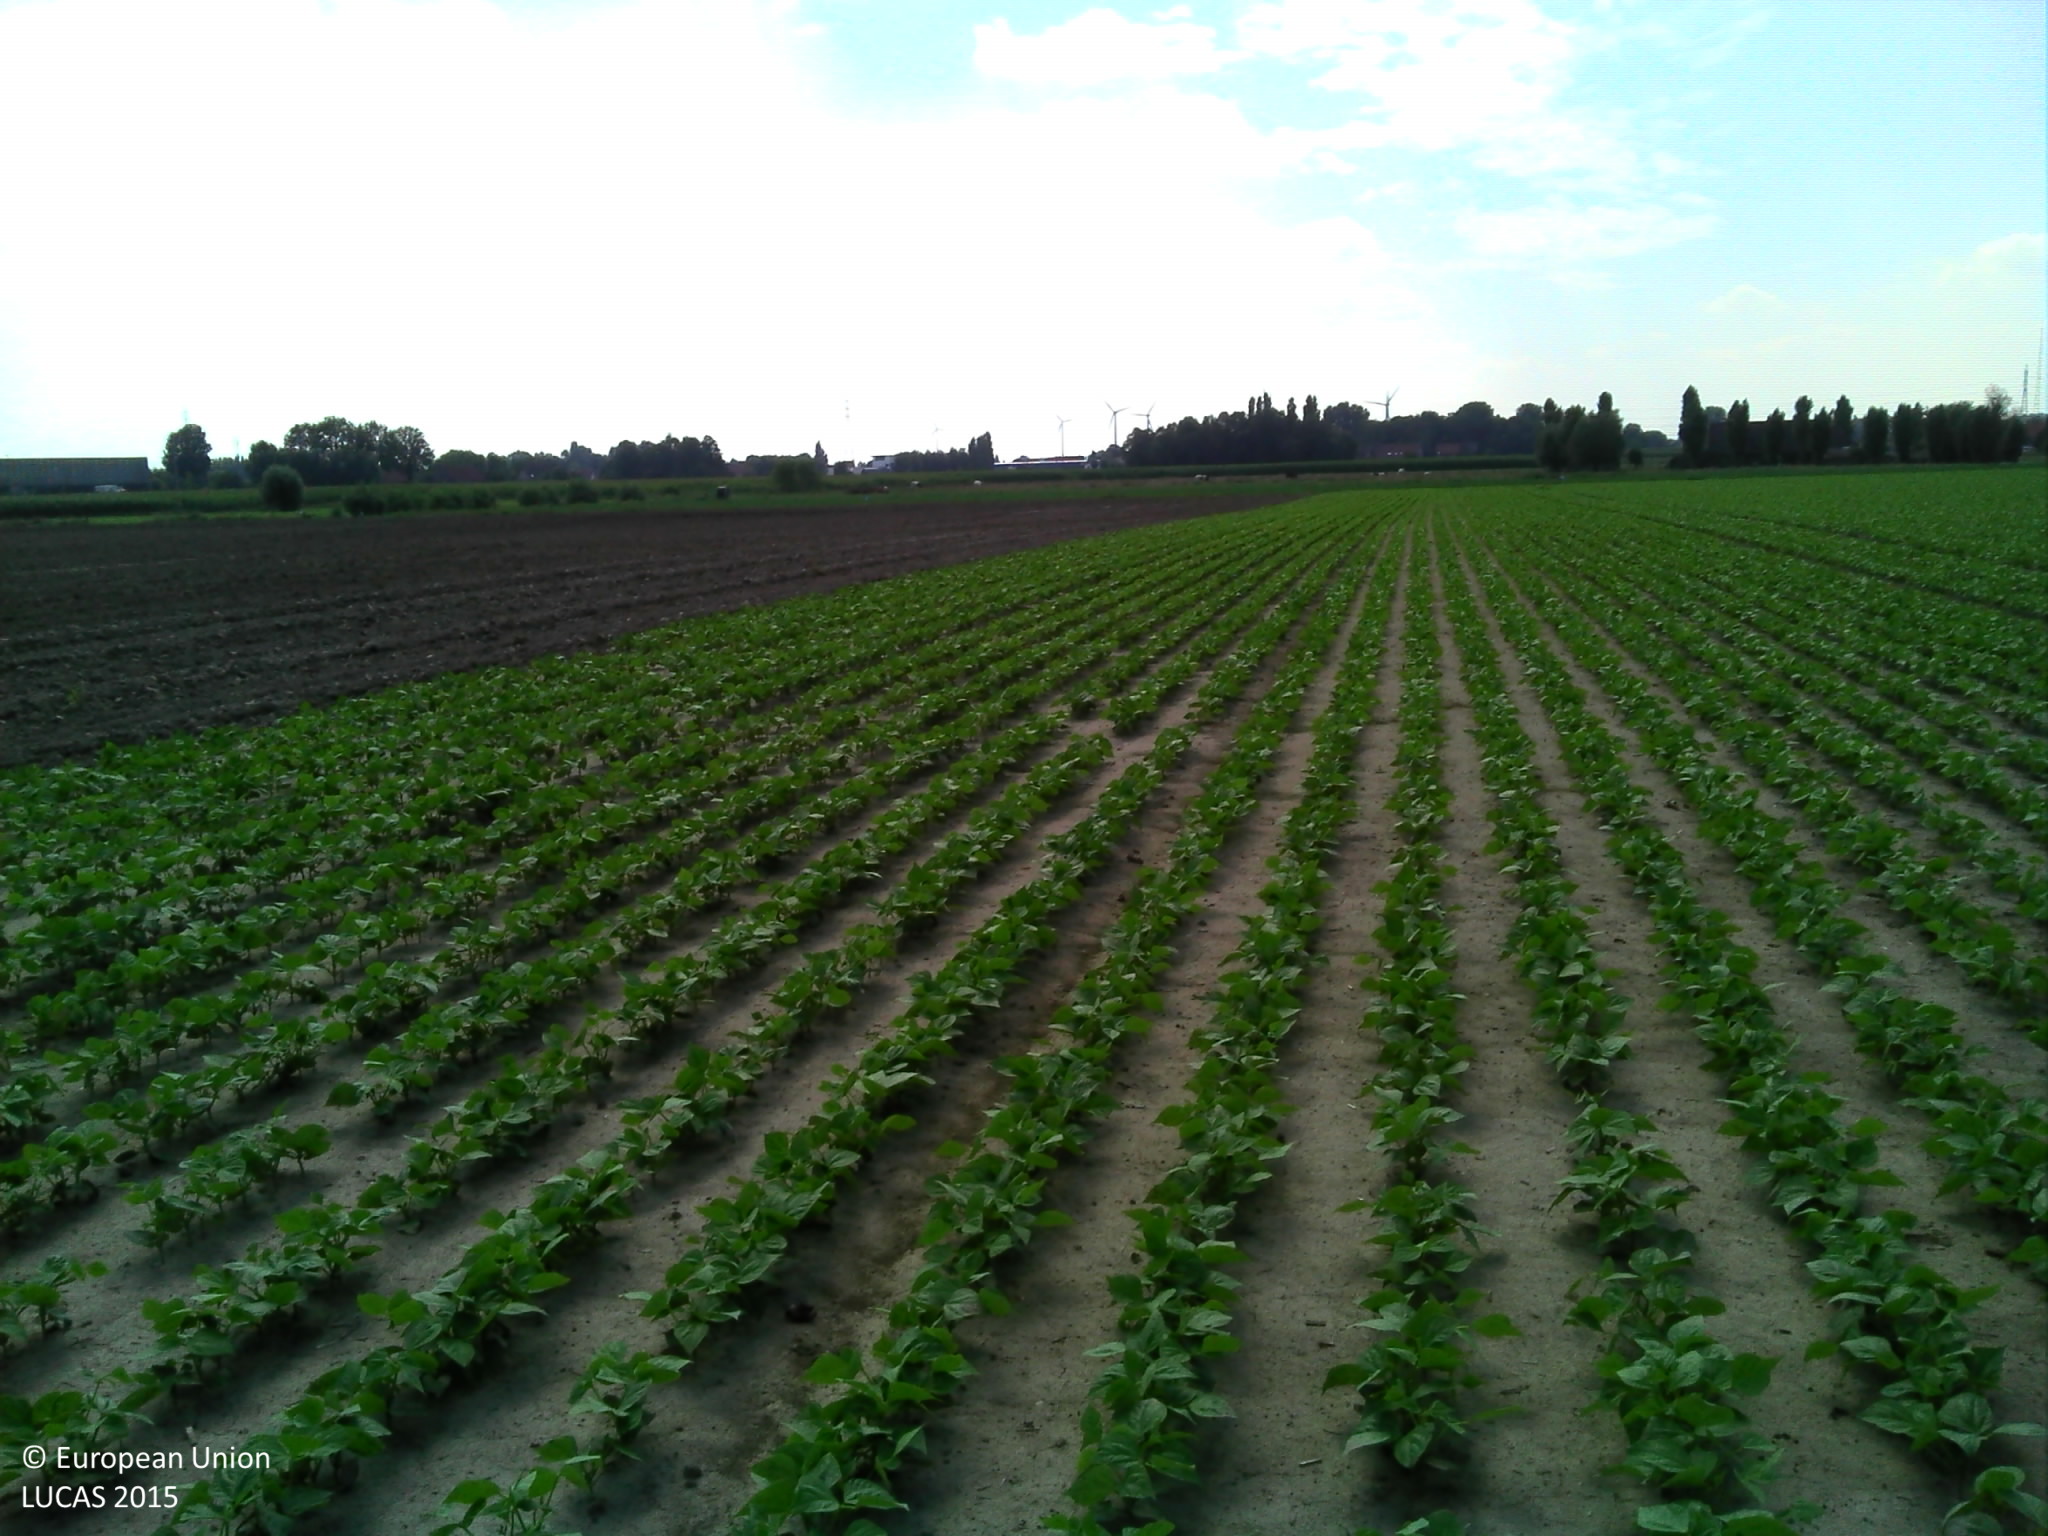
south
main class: Cropland
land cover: Other fresh vegetables
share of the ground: > 75 %
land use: Agriculture (excluding fallow land and kitchen gardens)
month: August
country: BE
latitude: 50.9718
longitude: 3.1692
